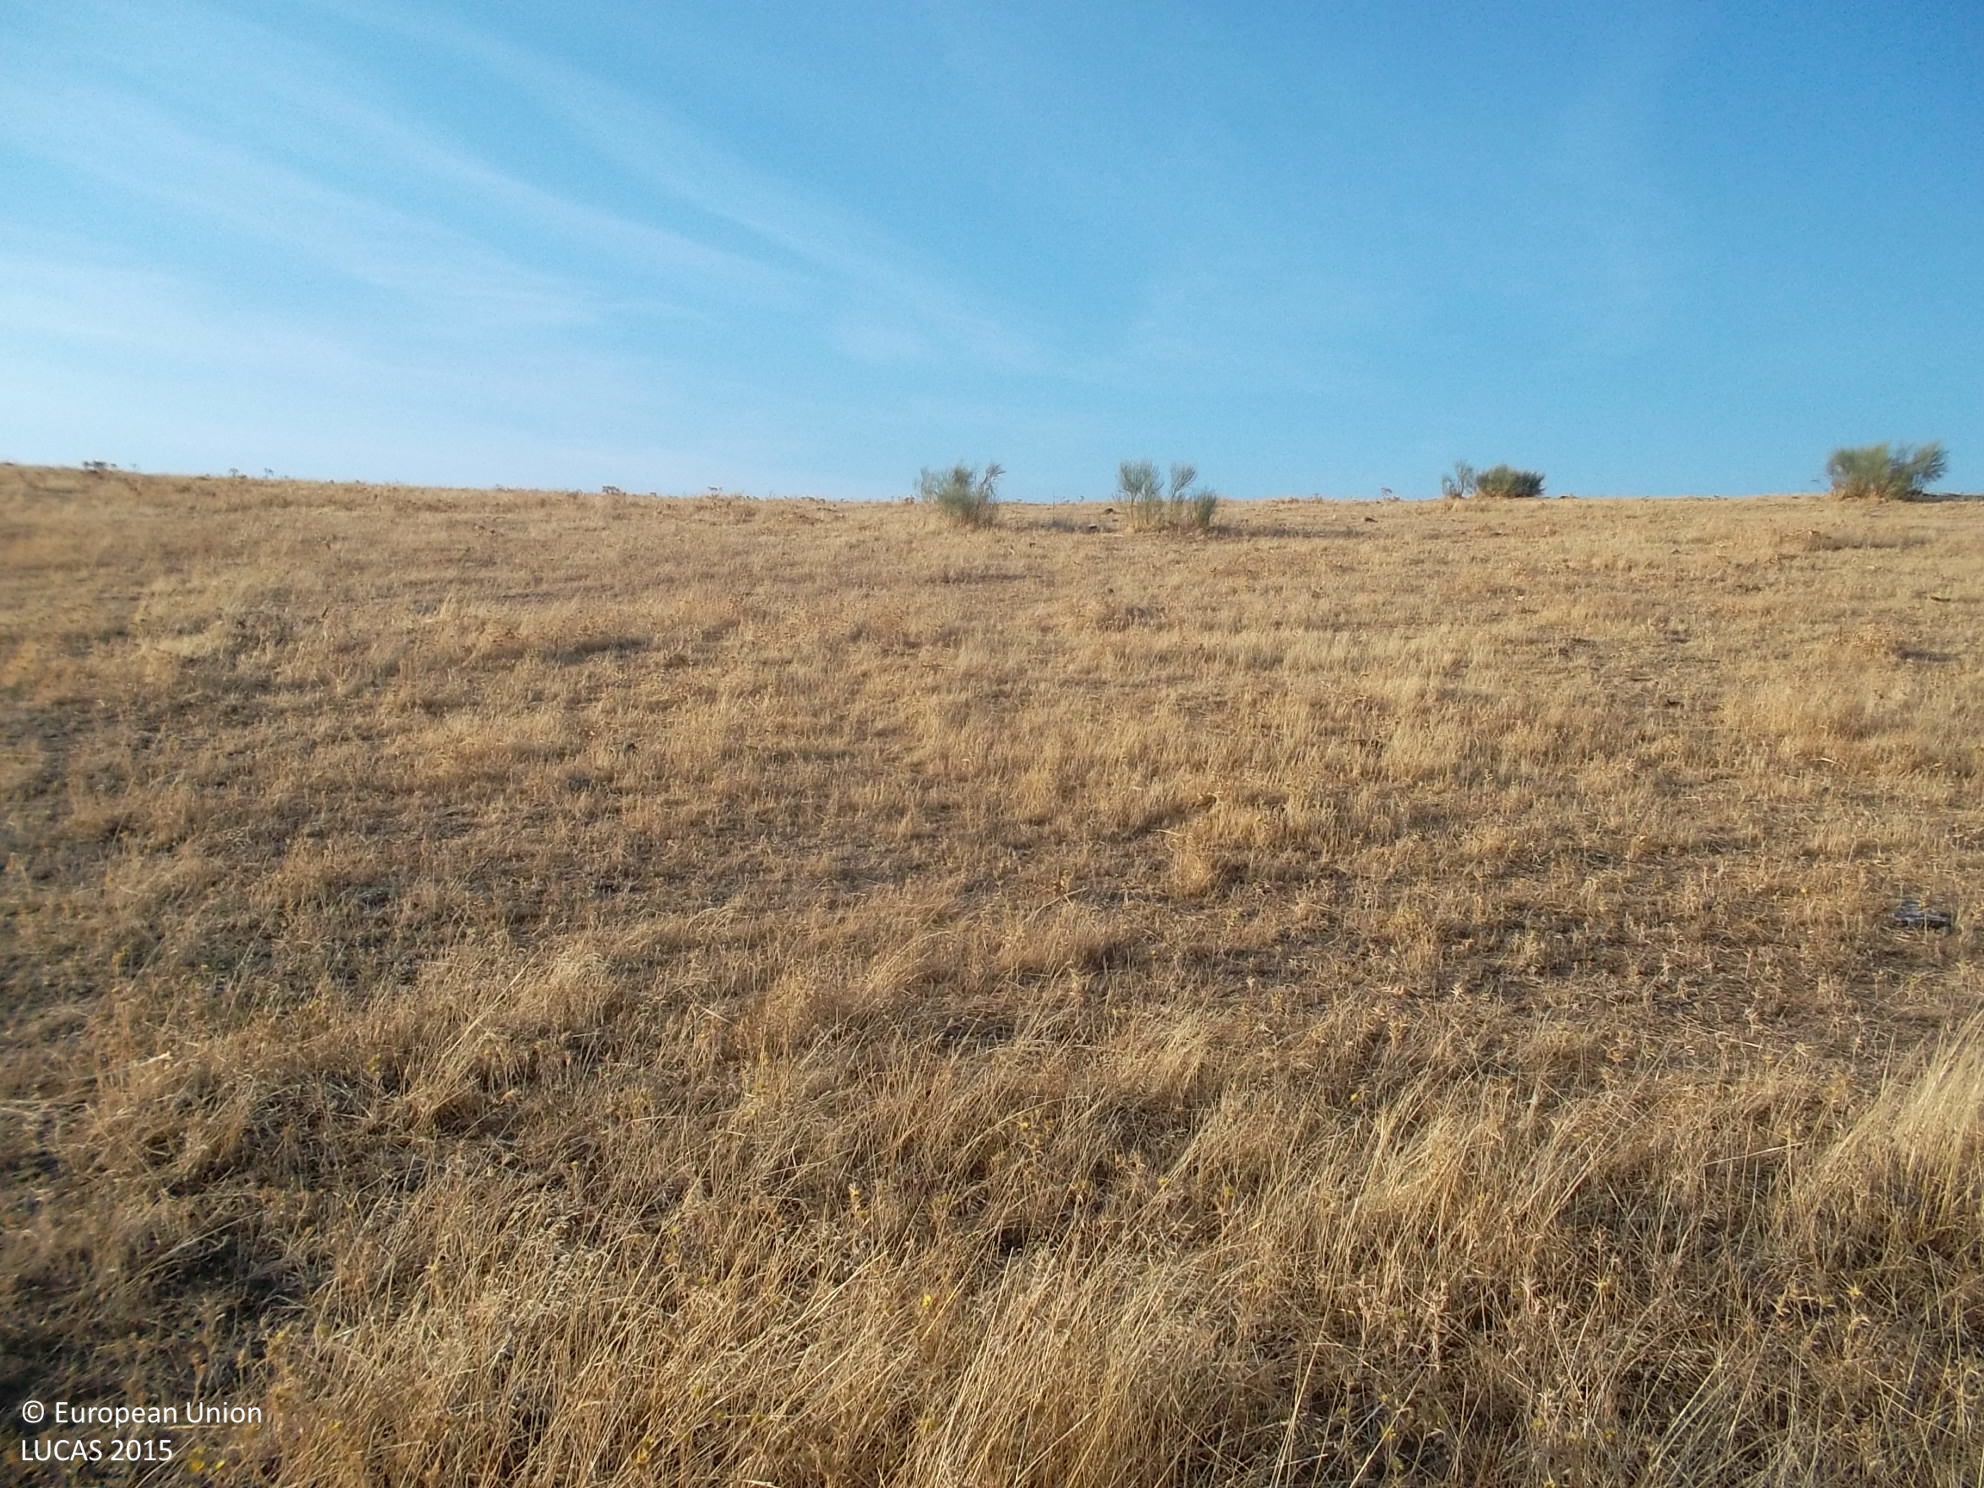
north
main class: Grassland
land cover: Grassland without tree/shrub cover
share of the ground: > 75 %
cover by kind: herbaceous plants 100 %
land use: Agriculture (excluding fallow land and kitchen gardens)
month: September
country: ES
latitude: 38.1558
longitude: -6.3058
